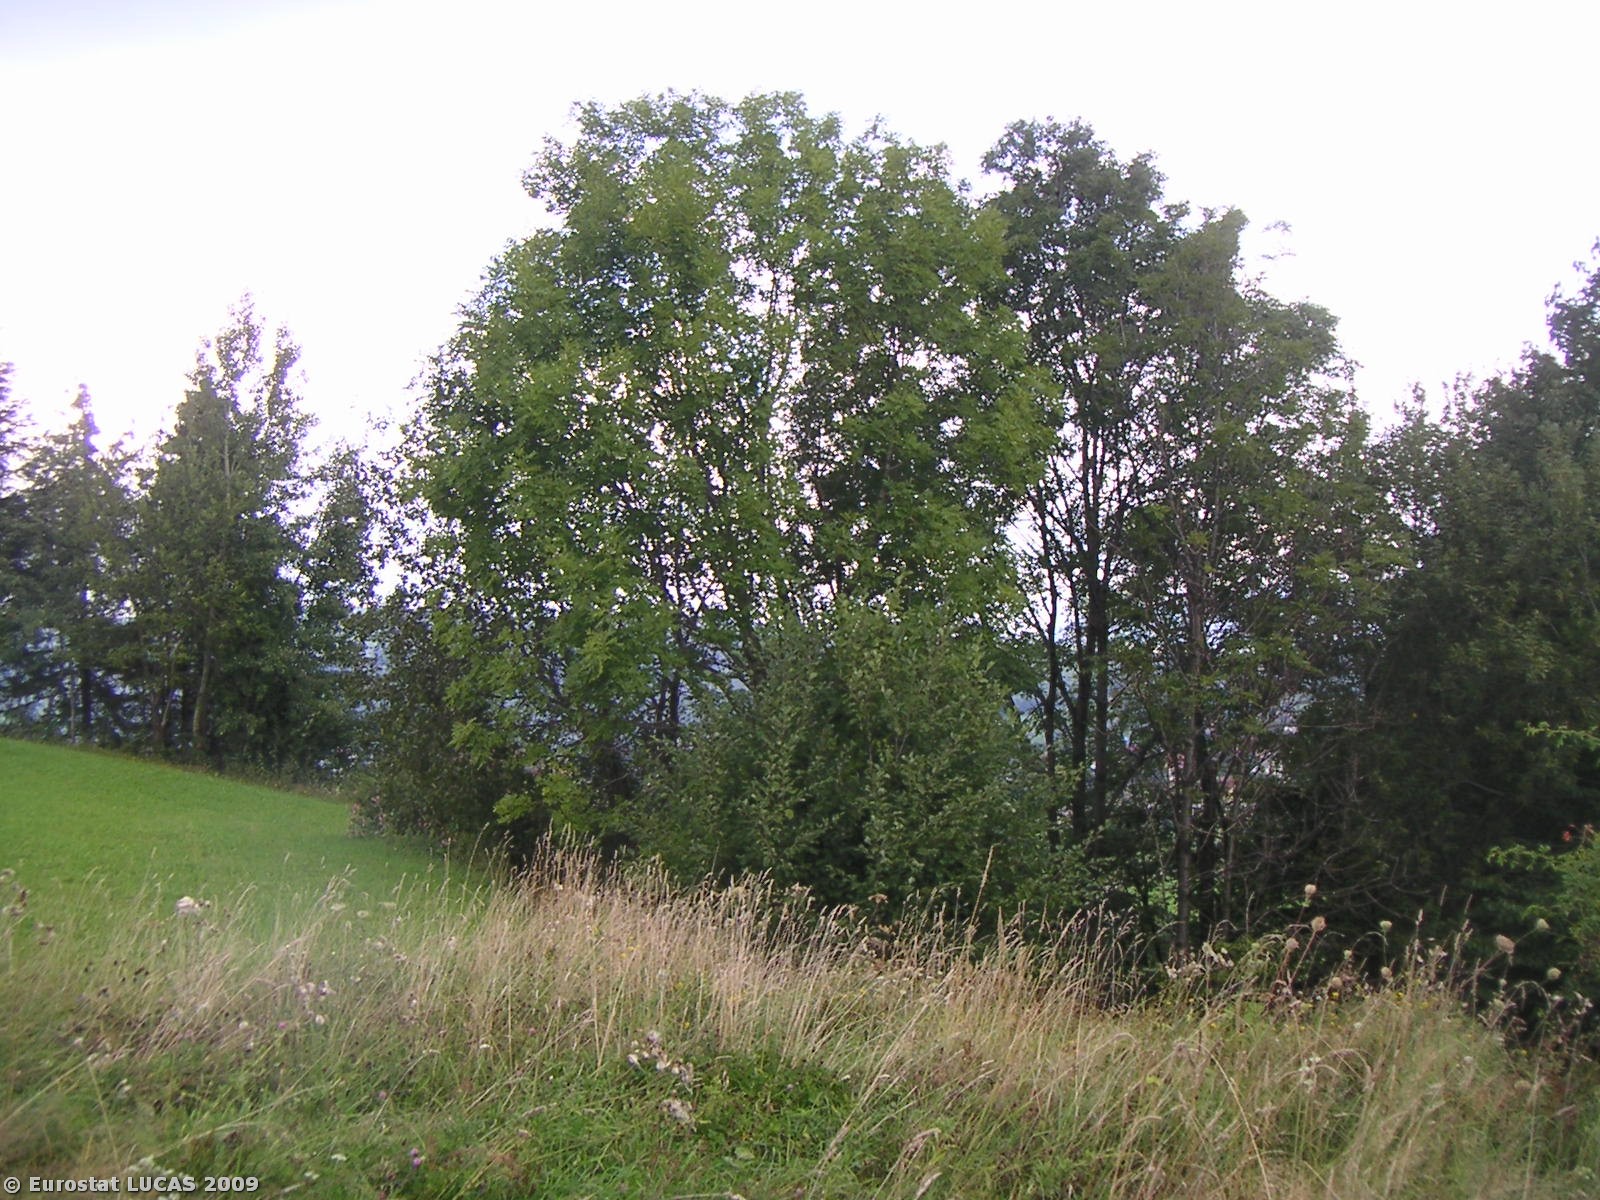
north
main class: Grassland
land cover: Spontaneously vegetated surfaces
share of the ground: > 75 %
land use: Fallow land
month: September
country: PL
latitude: 49.6058
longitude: 20.1208
